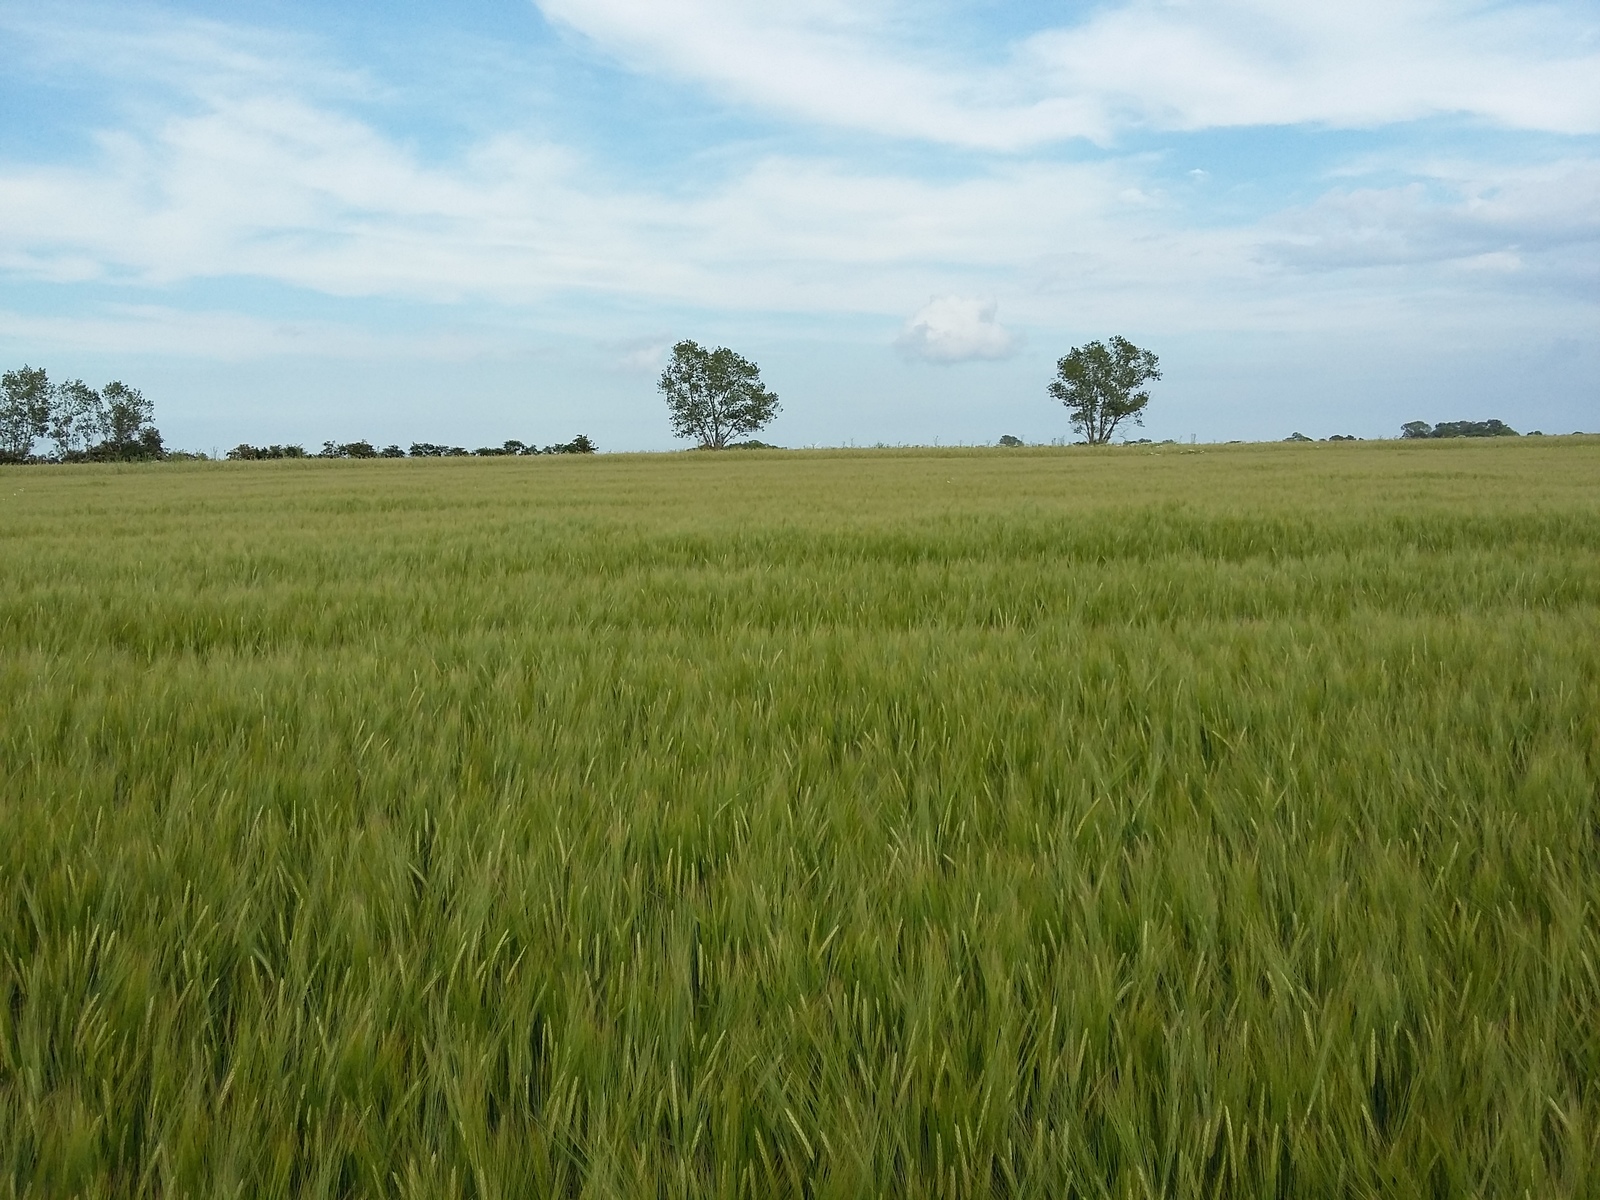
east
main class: Cropland
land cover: Barley
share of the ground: > 75 %
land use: Agriculture (excluding fallow land and kitchen gardens)
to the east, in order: Barley; Rye; Grassland with sparse tree/shrub cover; Barley
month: June
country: DK
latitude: 54.8056
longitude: 12.0057
